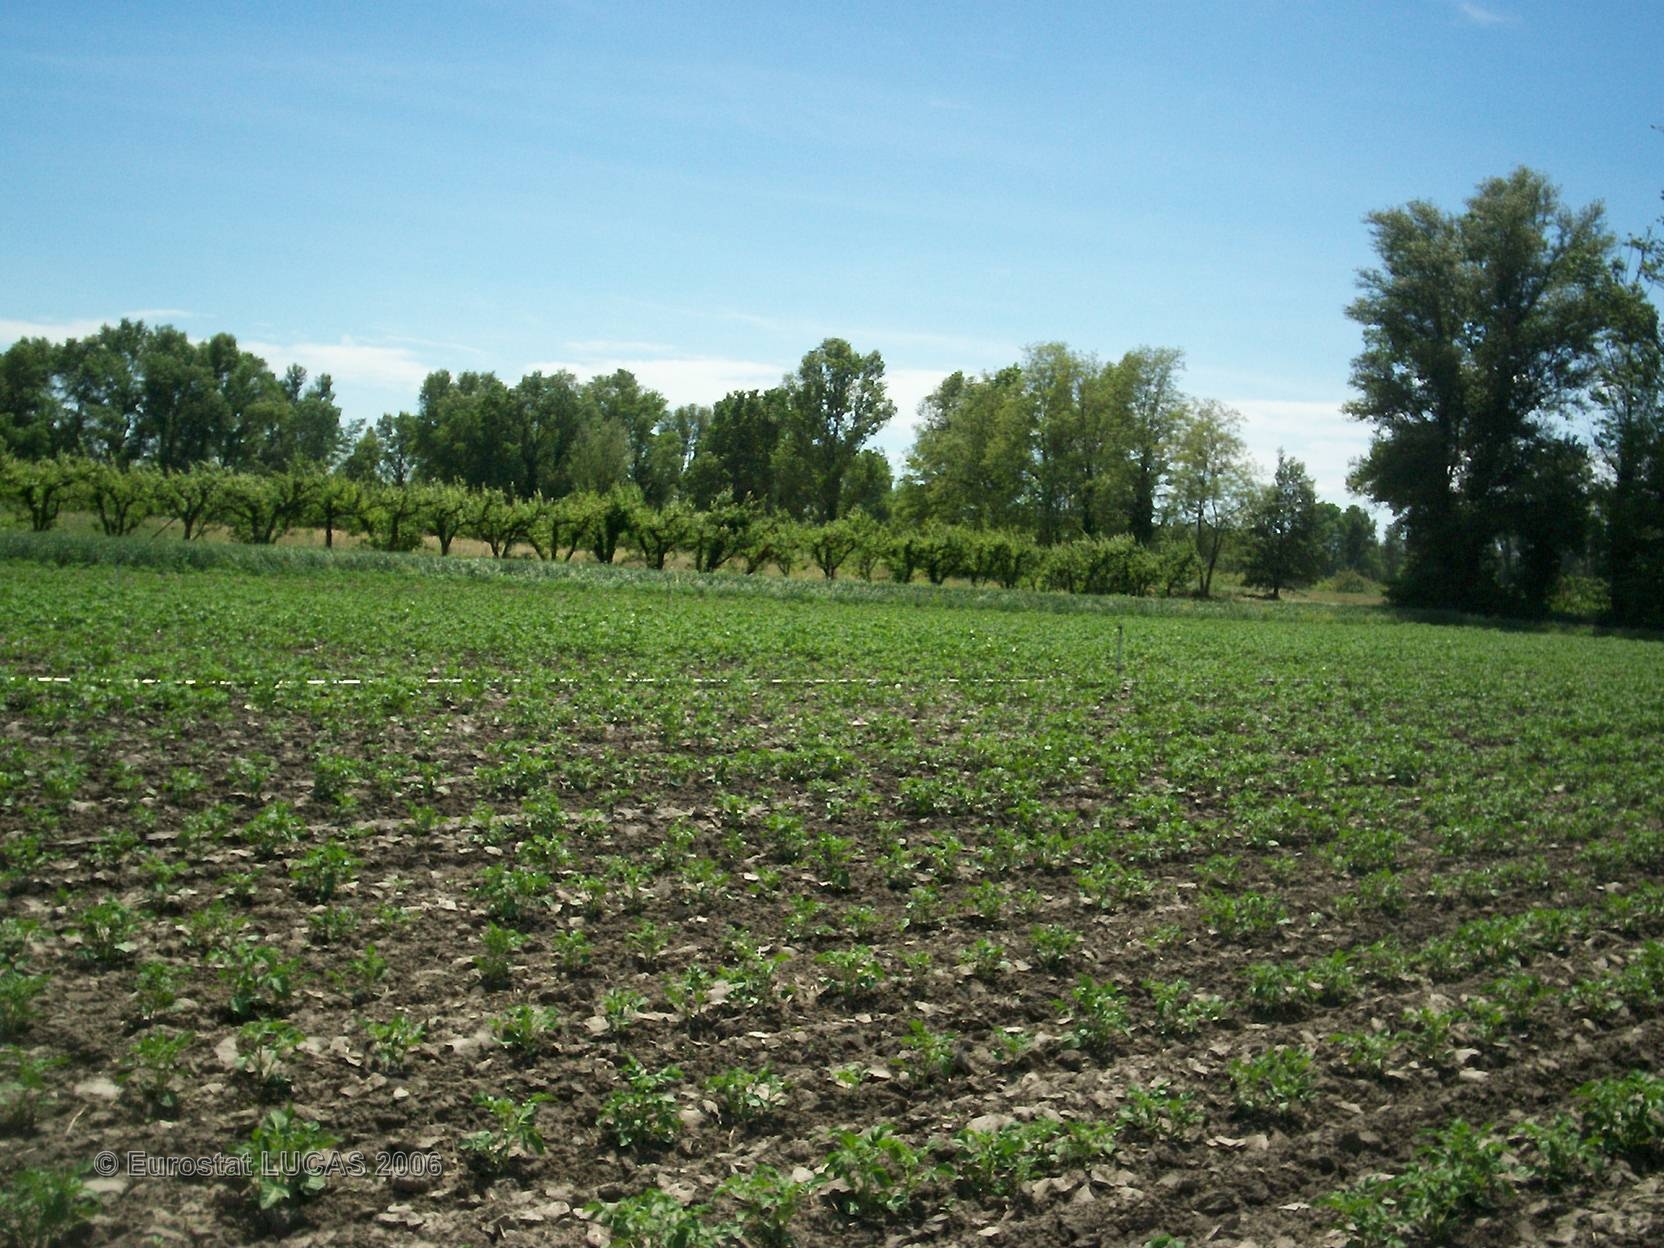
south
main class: Cropland
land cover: Potatoes
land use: Agriculture (excluding fallow land and kitchen gardens)
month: May
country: FR
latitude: 44.8733
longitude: 4.8541
